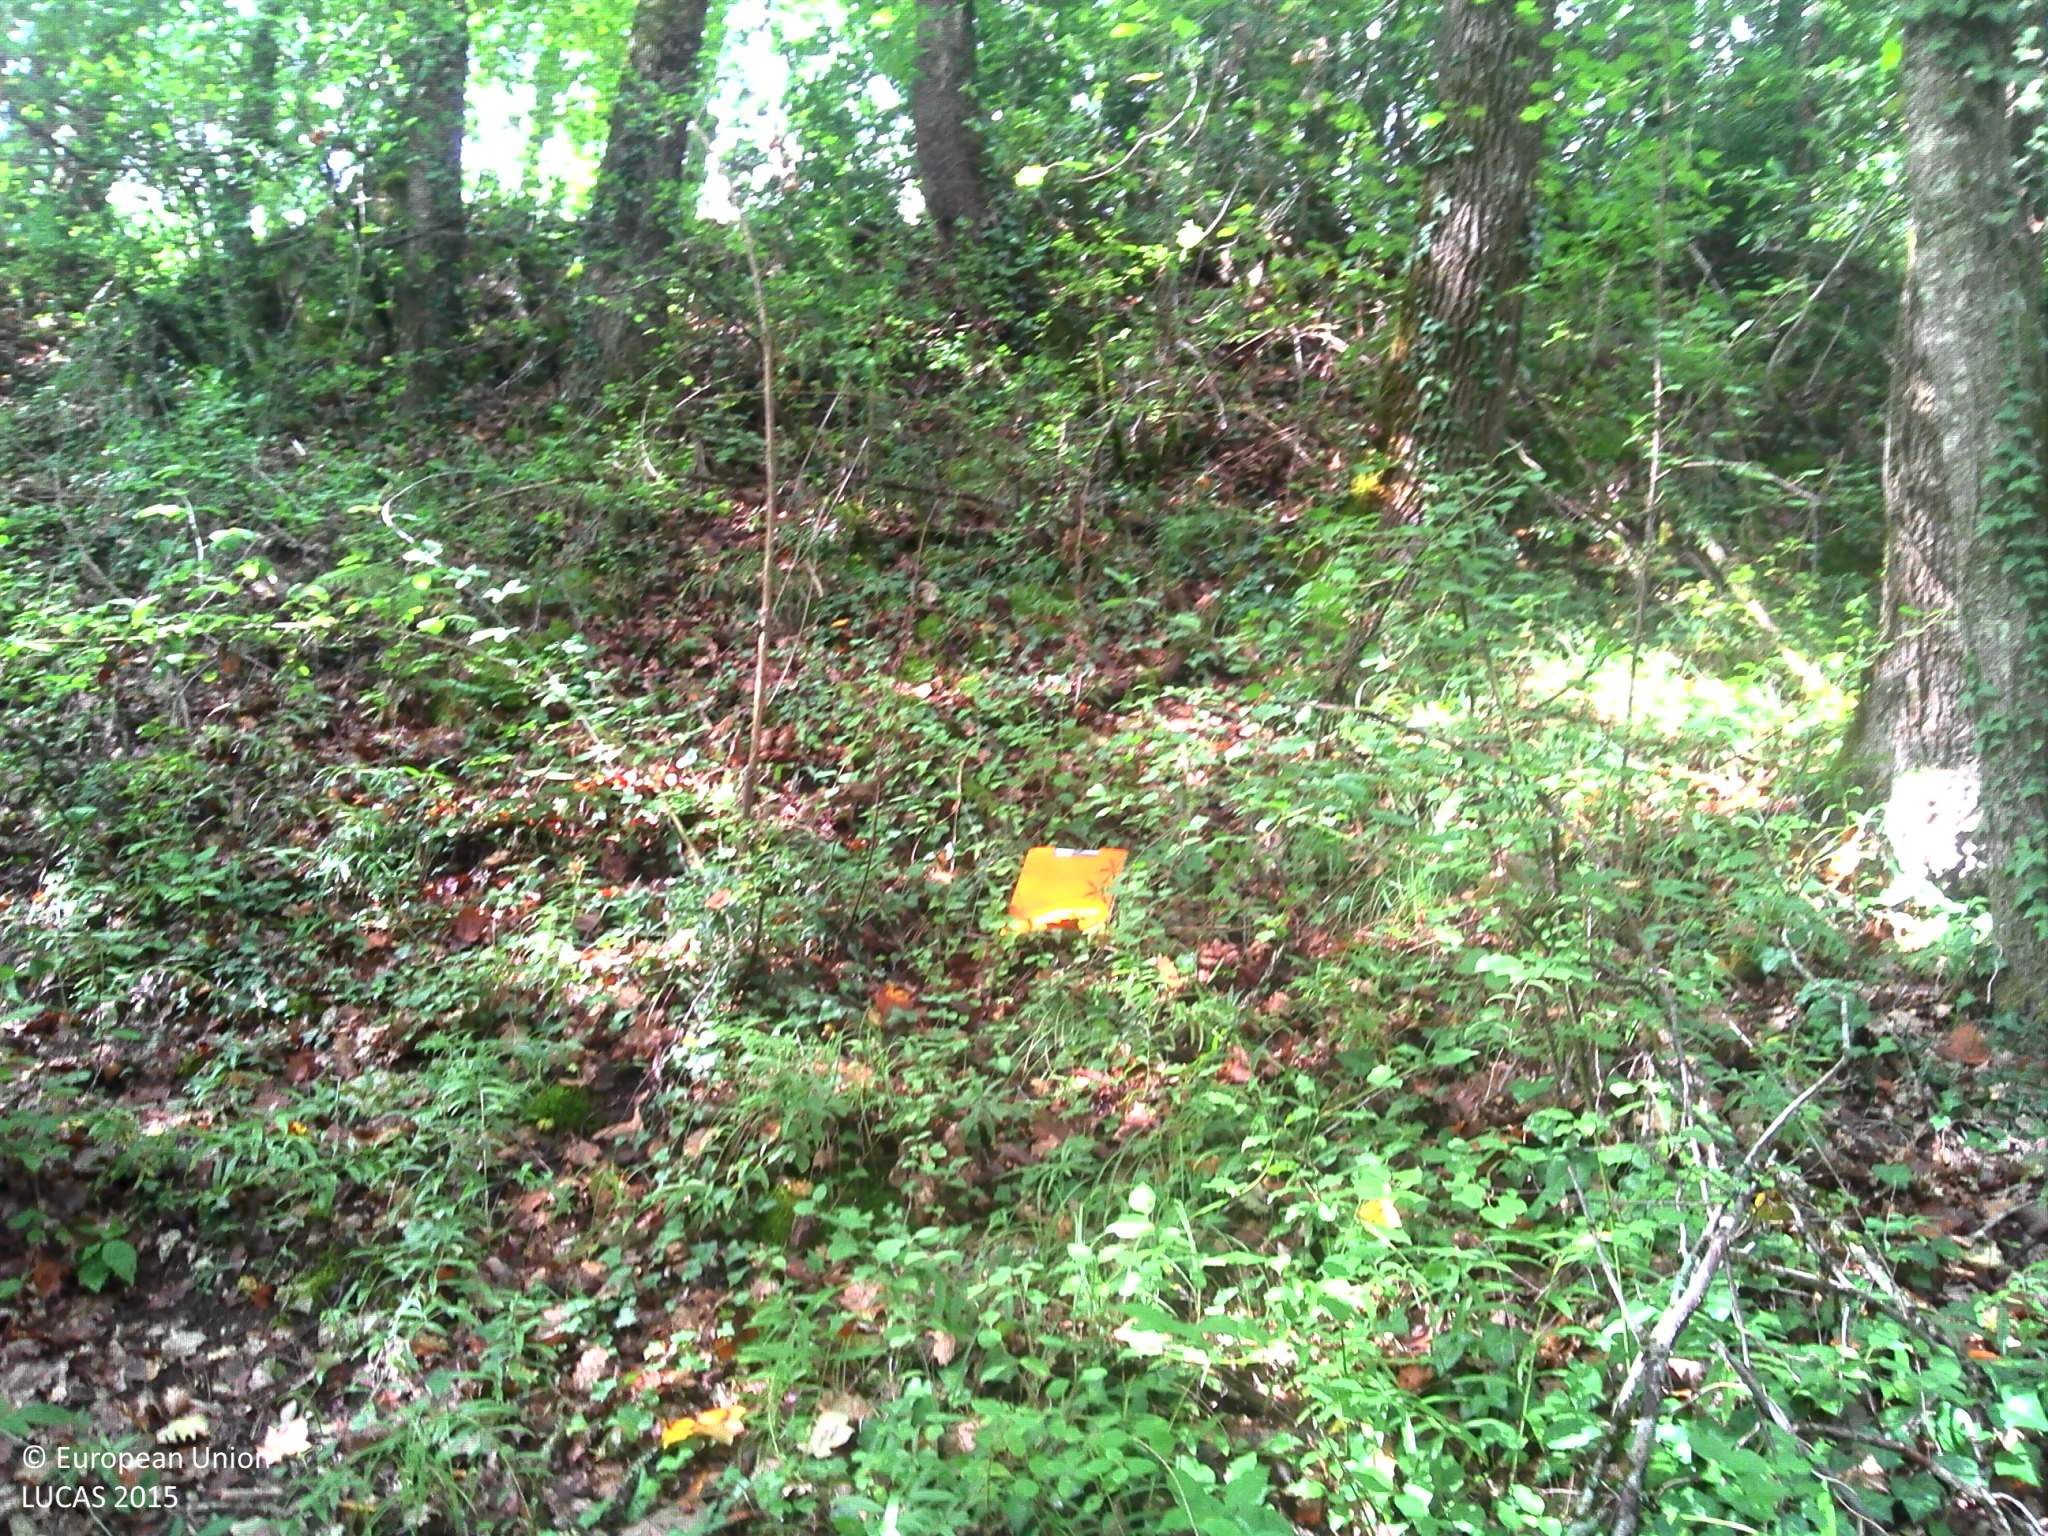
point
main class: Woodland
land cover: Broadleaved woodland
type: mesophytic deciduous forest
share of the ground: > 75 %
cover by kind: broadleaved forest trees 80 %, shrubs 10 %, herbaceous plants 10 %
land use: Forestry
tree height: > 5 m
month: August
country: FR
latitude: 44.2581
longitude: 1.3184
